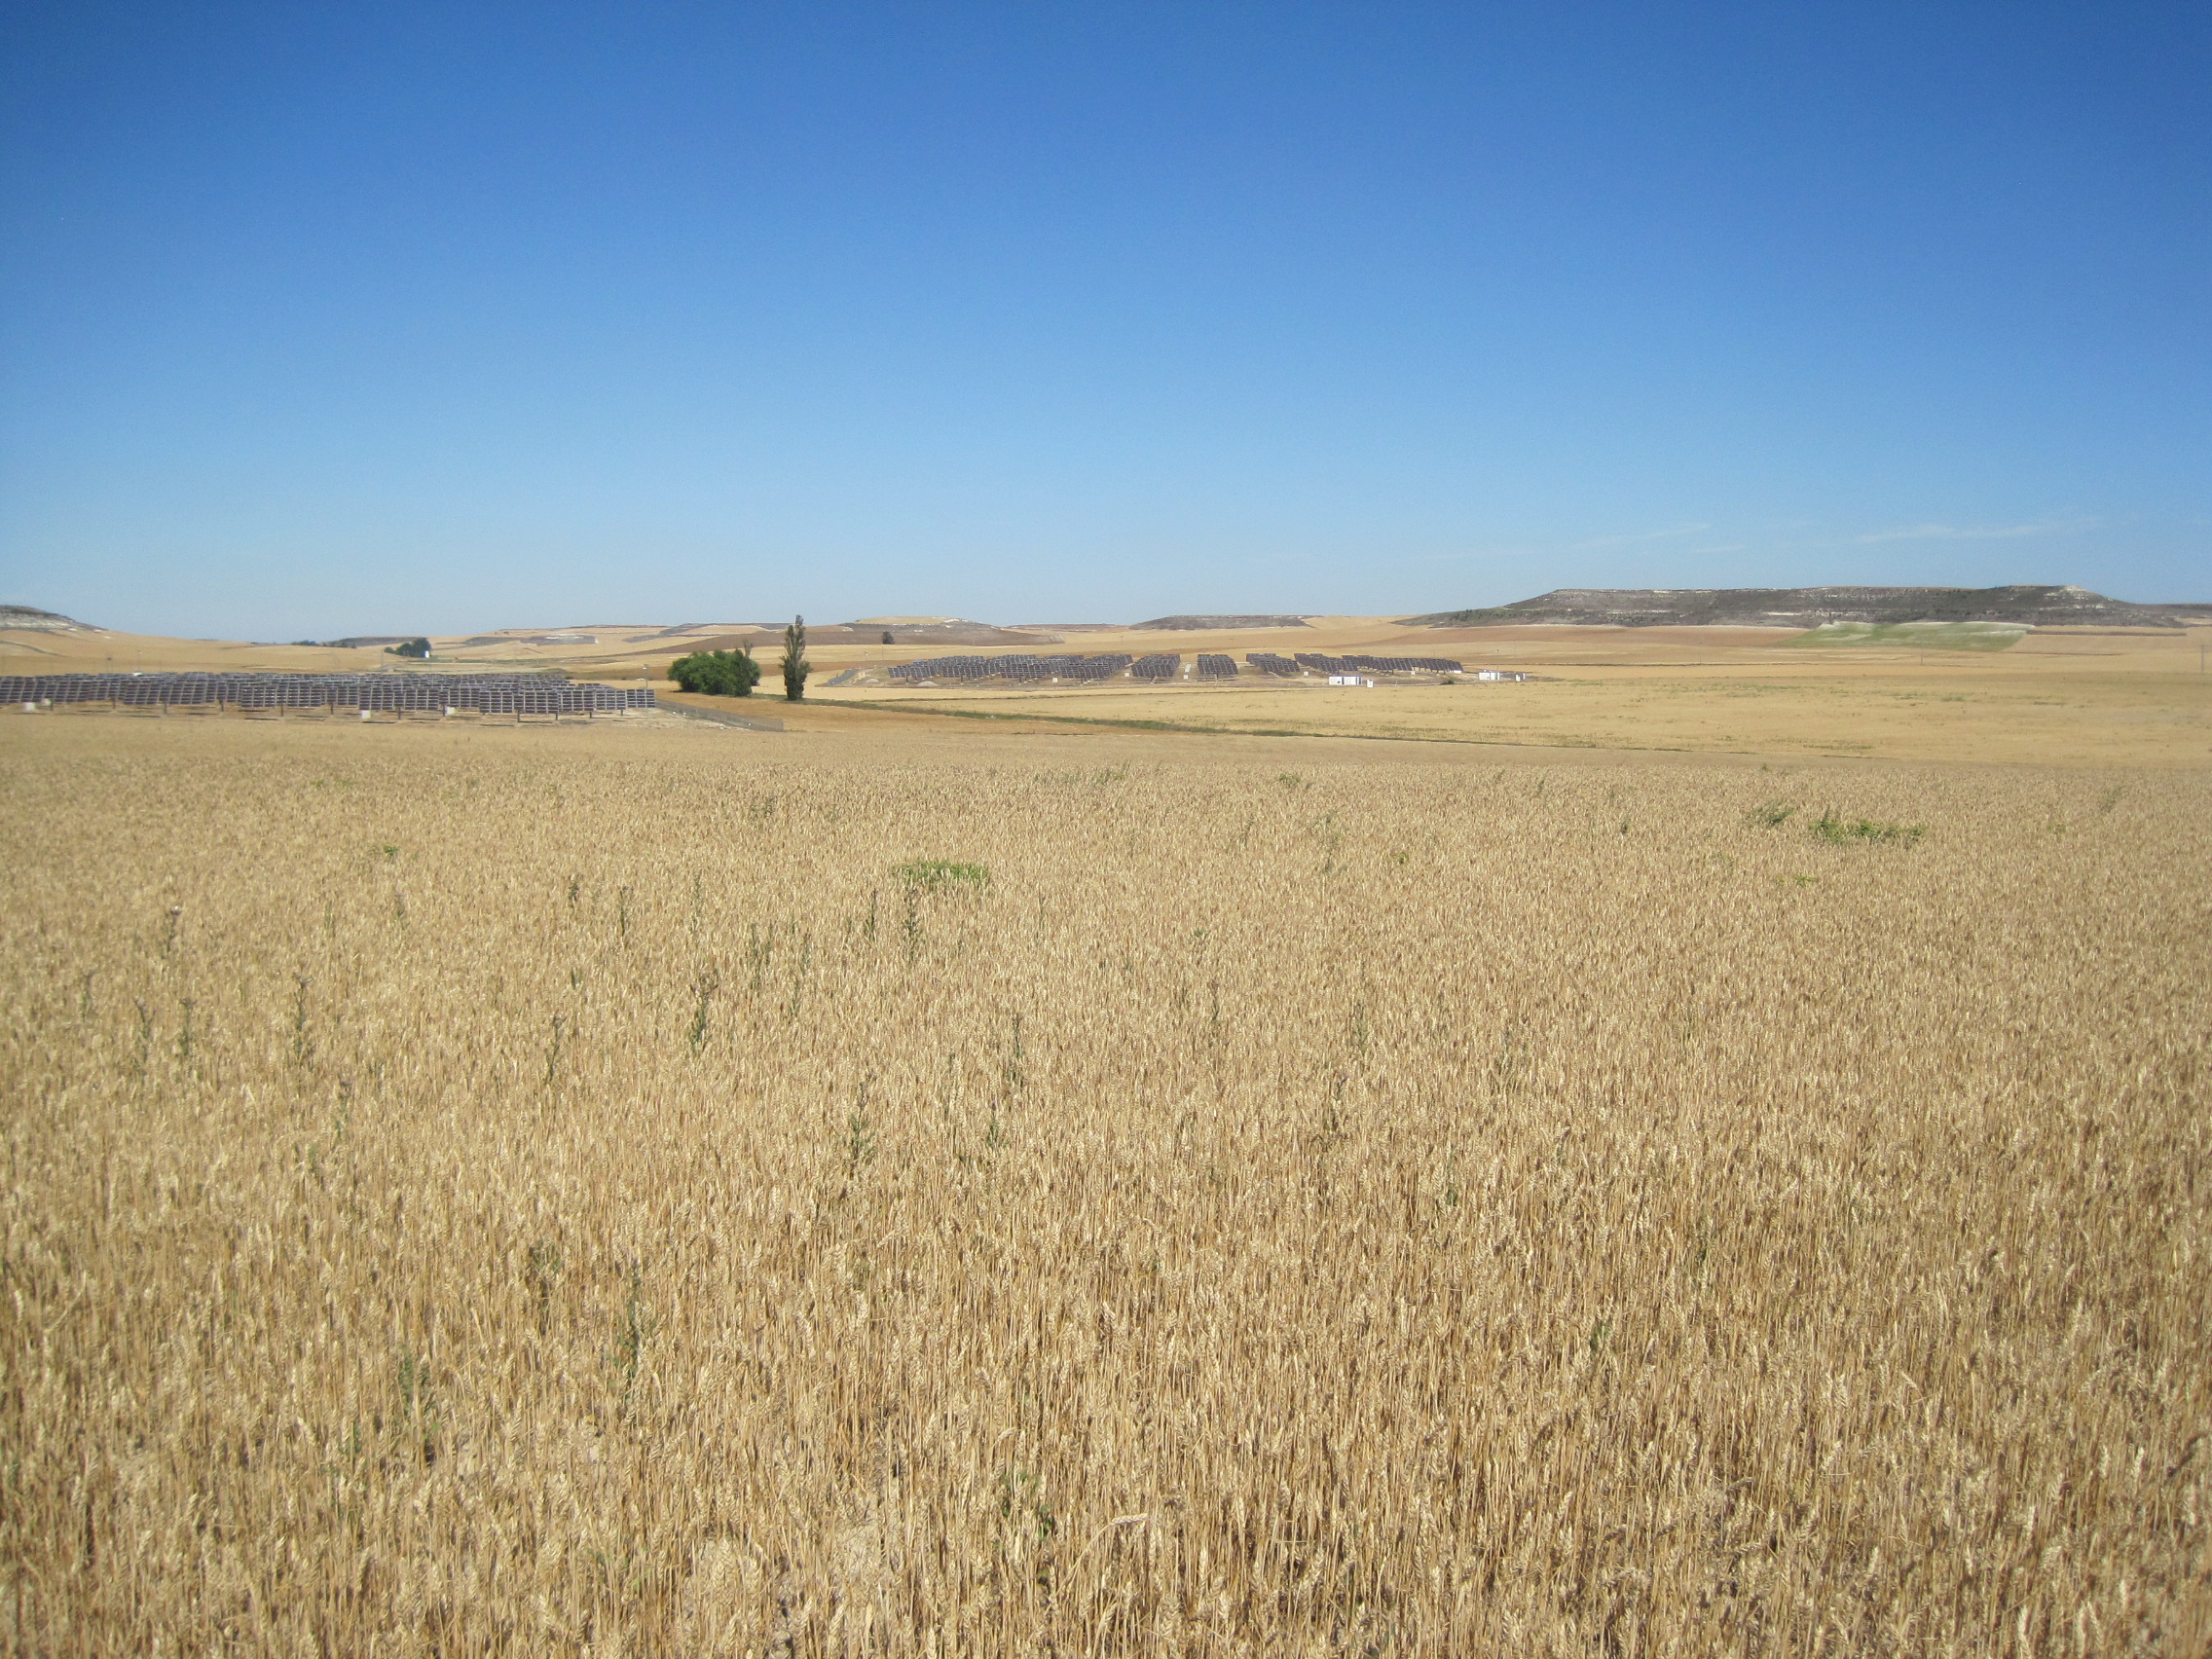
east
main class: Cropland
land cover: Common wheat
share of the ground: > 75 %
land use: Agriculture (excluding fallow land and kitchen gardens)
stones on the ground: 10 - 25 %
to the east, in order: Common wheat
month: June
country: ES
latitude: 41.6328
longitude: -5.1659
